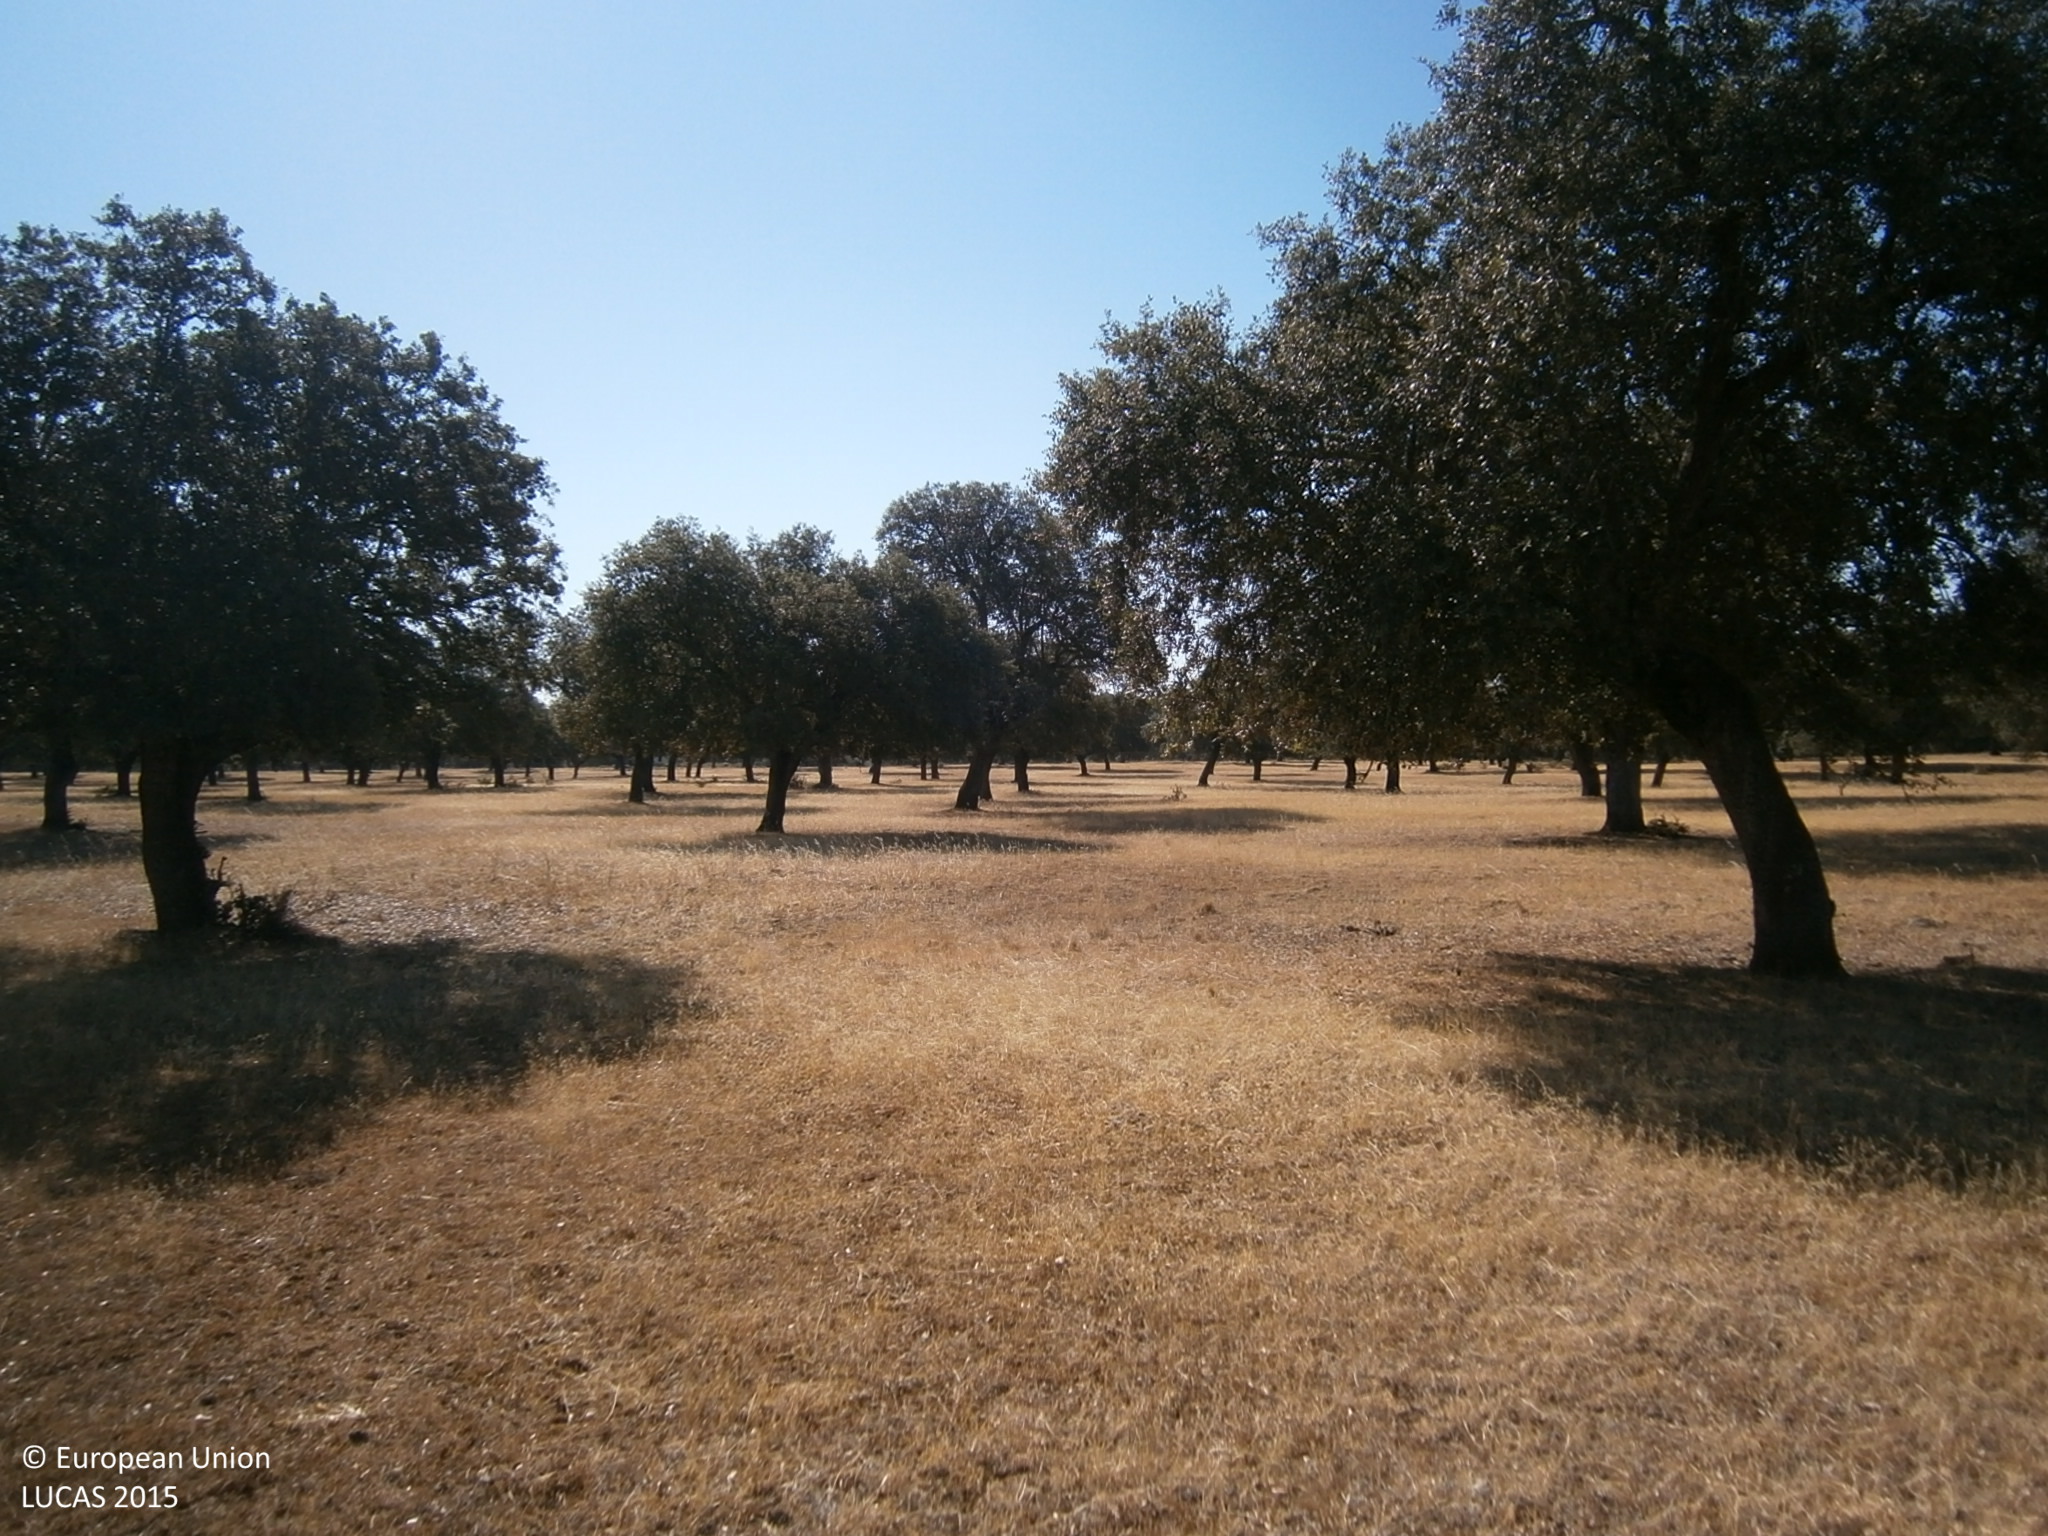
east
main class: Woodland
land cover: Broadleaved woodland
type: broadleaved evergreen forest
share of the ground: 25 - 50 %
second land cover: Spontaneously vegetated surfaces
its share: 50 - 75 %
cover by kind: broadleaved forest trees 40 %, herbaceous plants 40 %, unconsolidated bare surface 20 %
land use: Forestry
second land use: Agriculture (excluding fallow land and kitchen gardens)
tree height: > 5 m
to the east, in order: Broadleaved woodland; Spontaneously vegetated surfaces
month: July
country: ES
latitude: 38.9741
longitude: -6.7929
